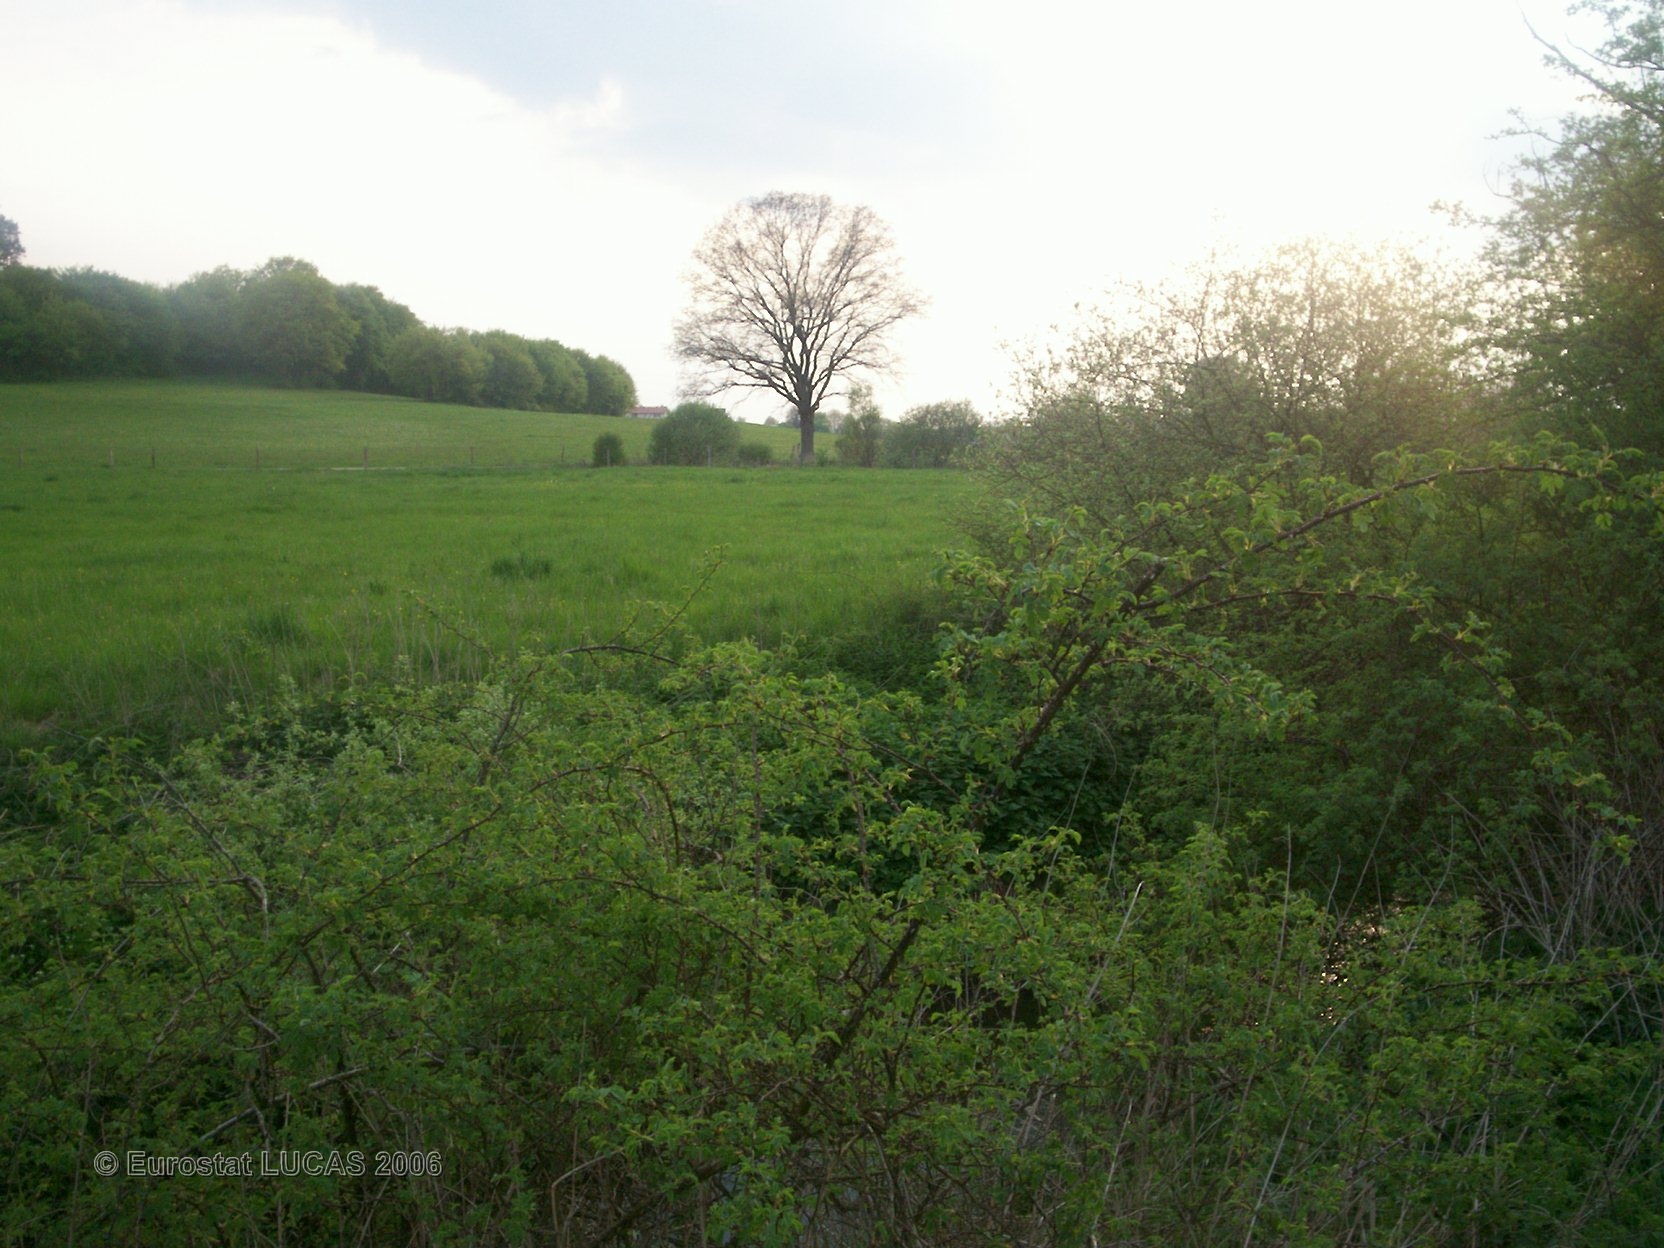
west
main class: Grassland
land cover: Grassland without tree/shrub cover
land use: Agriculture (excluding fallow land and kitchen gardens)
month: May
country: FR
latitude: 48.7588
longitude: 6.9943
